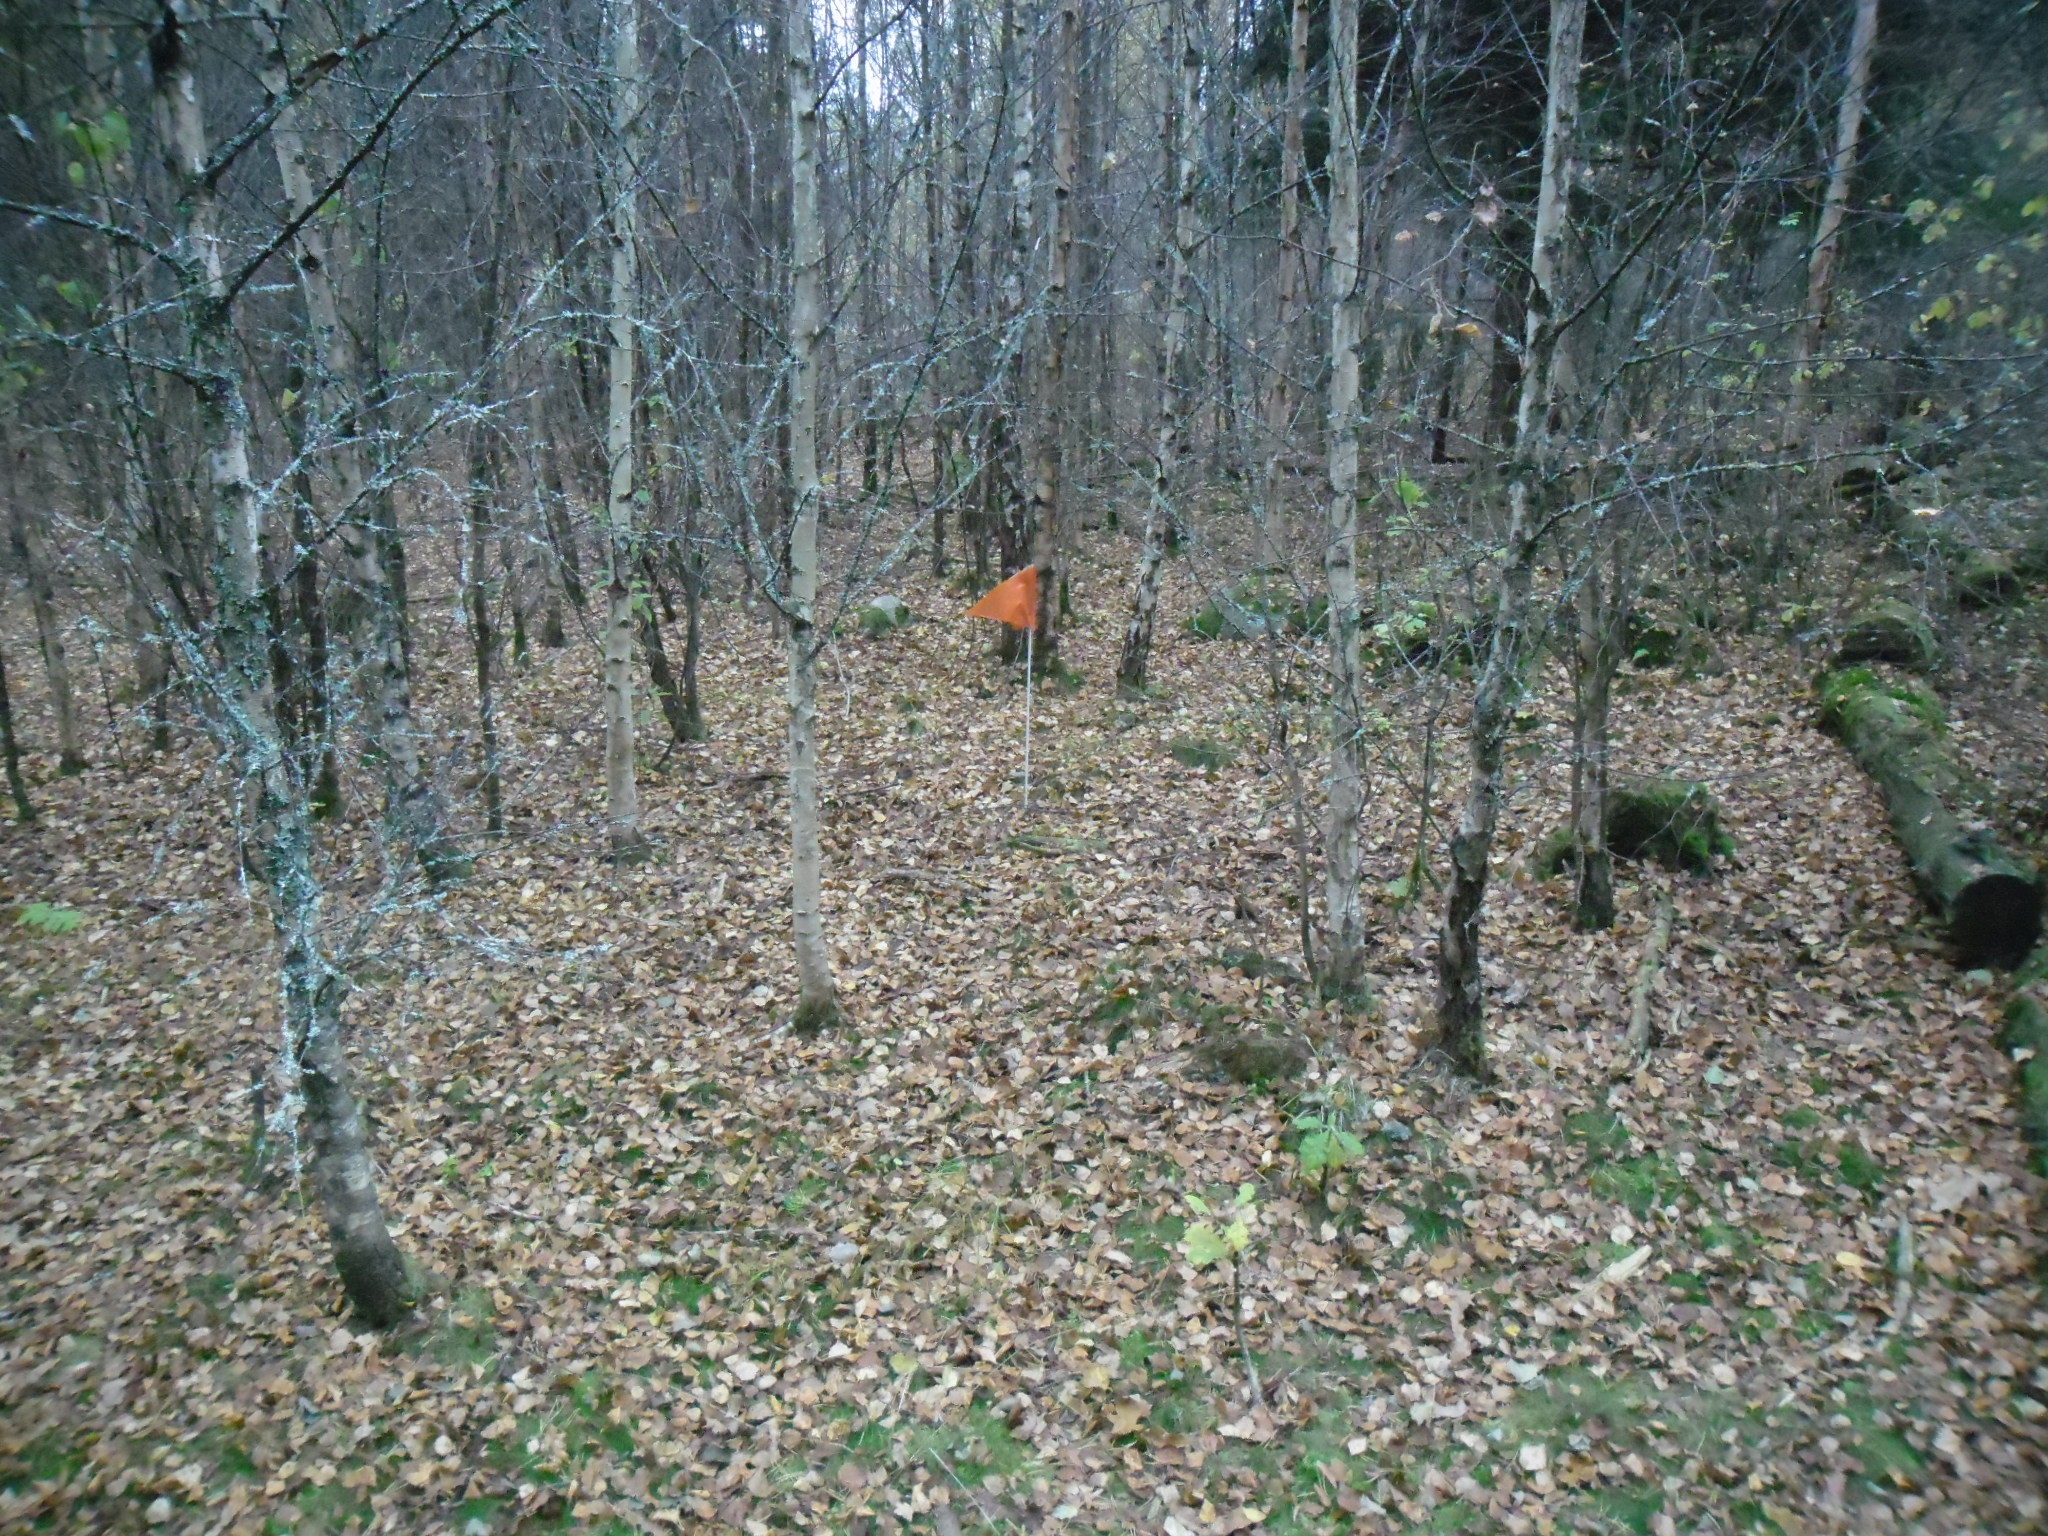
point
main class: Woodland
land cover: Broadleaved woodland
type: hemiboreal forest and nemoral coniferous forest and mixed broadleaved-coniferous forest
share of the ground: 50 - 75 %
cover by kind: broadleaved forest trees 75 %, herbaceous plants 25 %
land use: Forestry
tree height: < 5 m
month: October
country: SE
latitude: 56.3586
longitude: 14.0274
